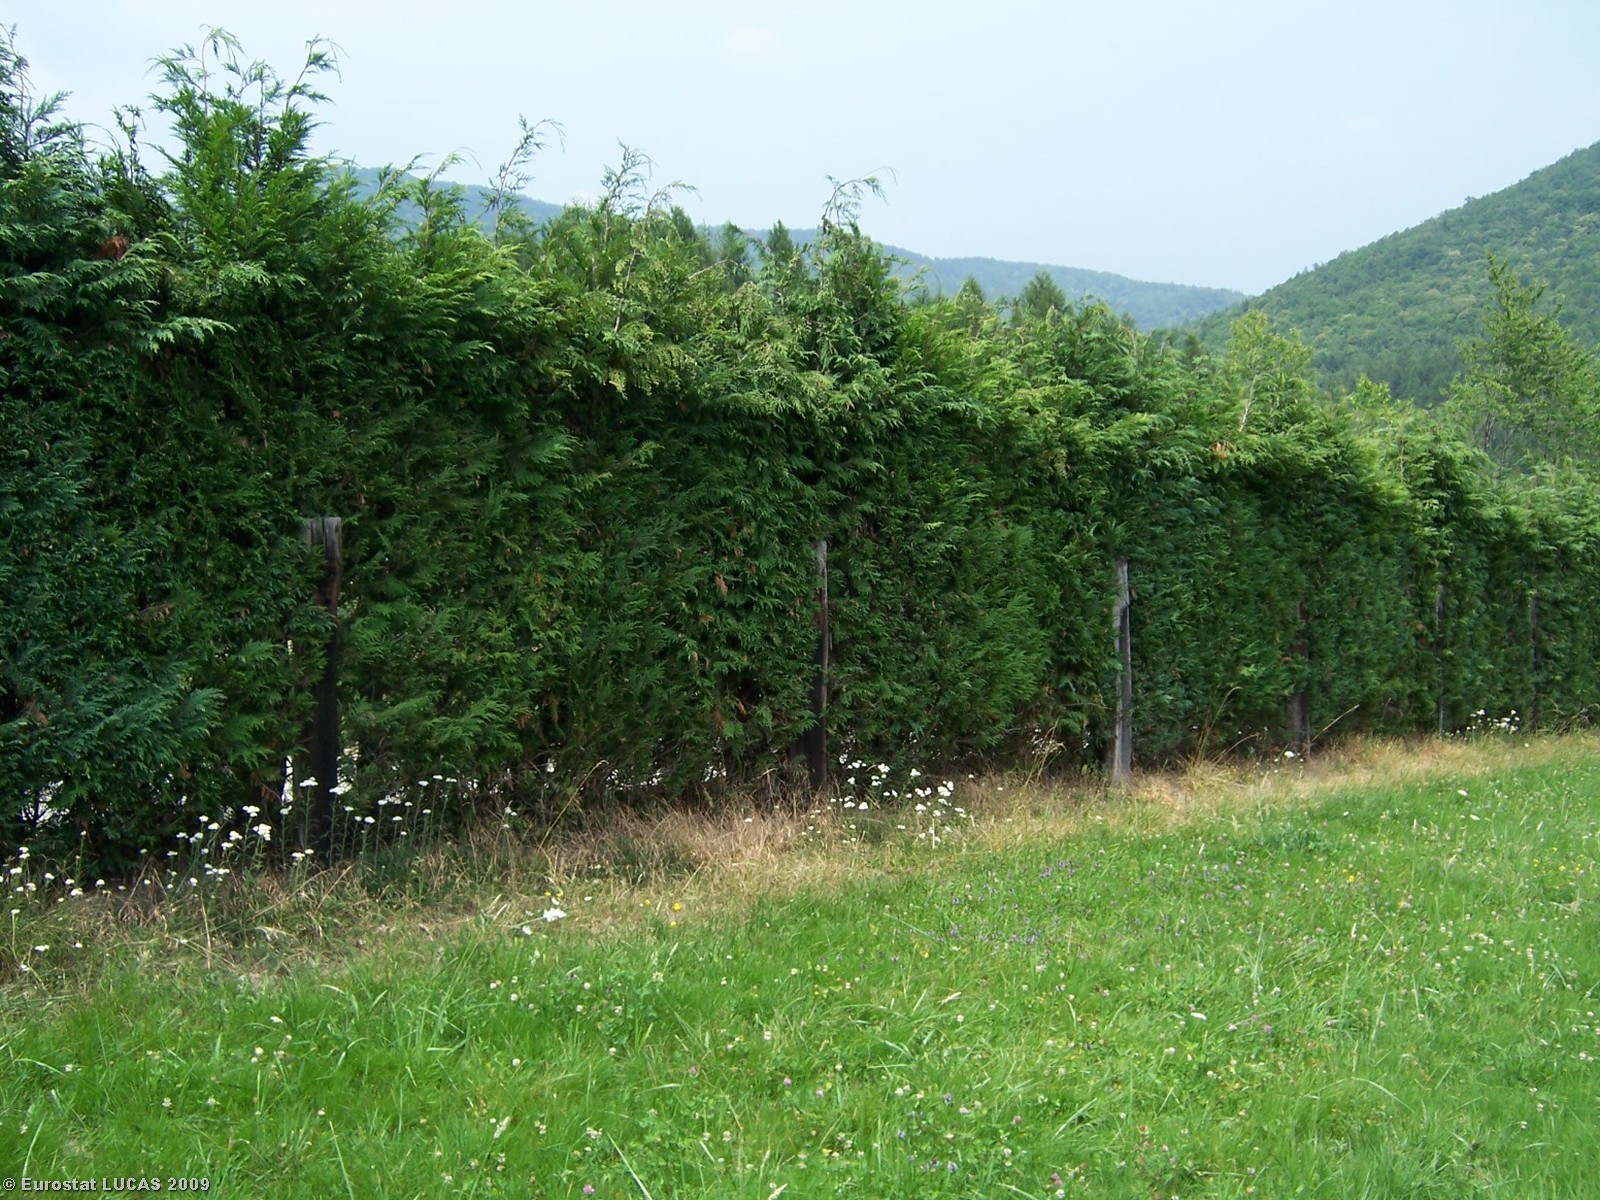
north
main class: Grassland
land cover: Grassland without tree/shrub cover
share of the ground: > 75 %
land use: Agriculture (excluding fallow land and kitchen gardens)
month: July
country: IT
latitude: 45.0558
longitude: 7.3252
